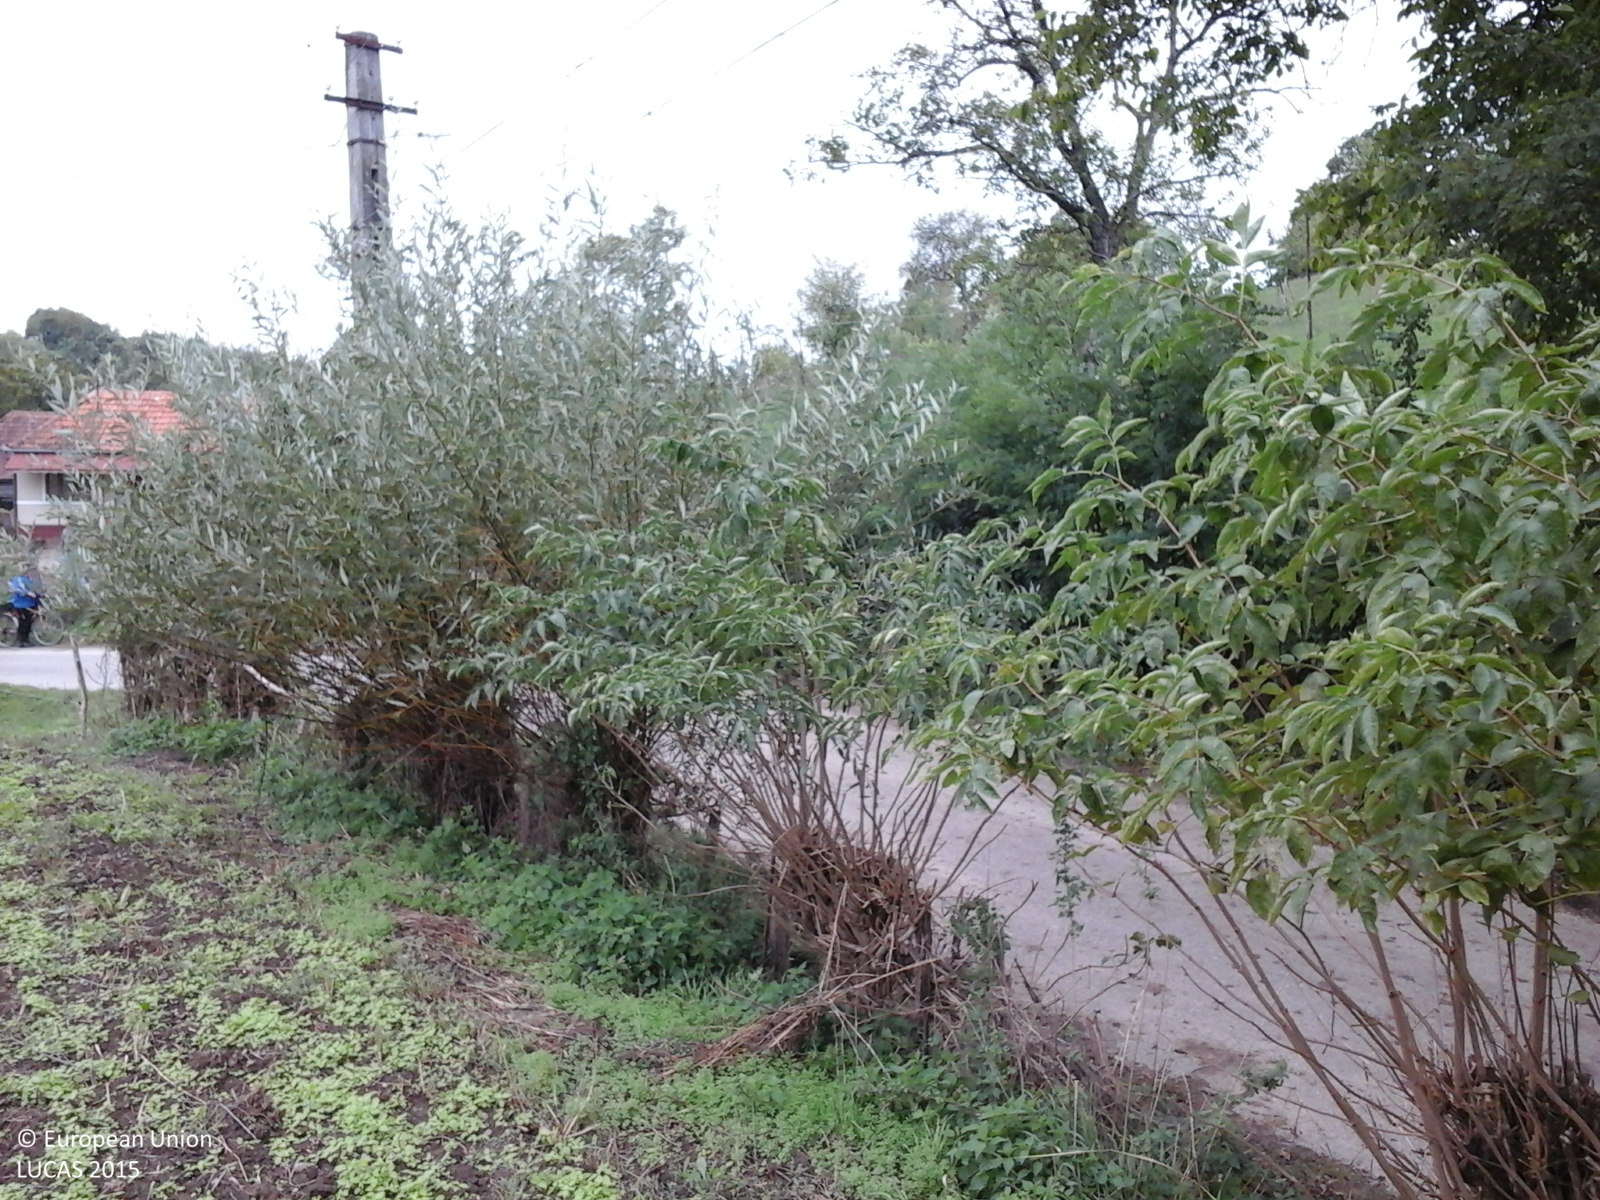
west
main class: Cropland
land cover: Maize
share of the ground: < 10 %
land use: Agriculture (excluding fallow land and kitchen gardens)
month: September
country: RO
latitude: 45.9555
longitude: 22.9966
